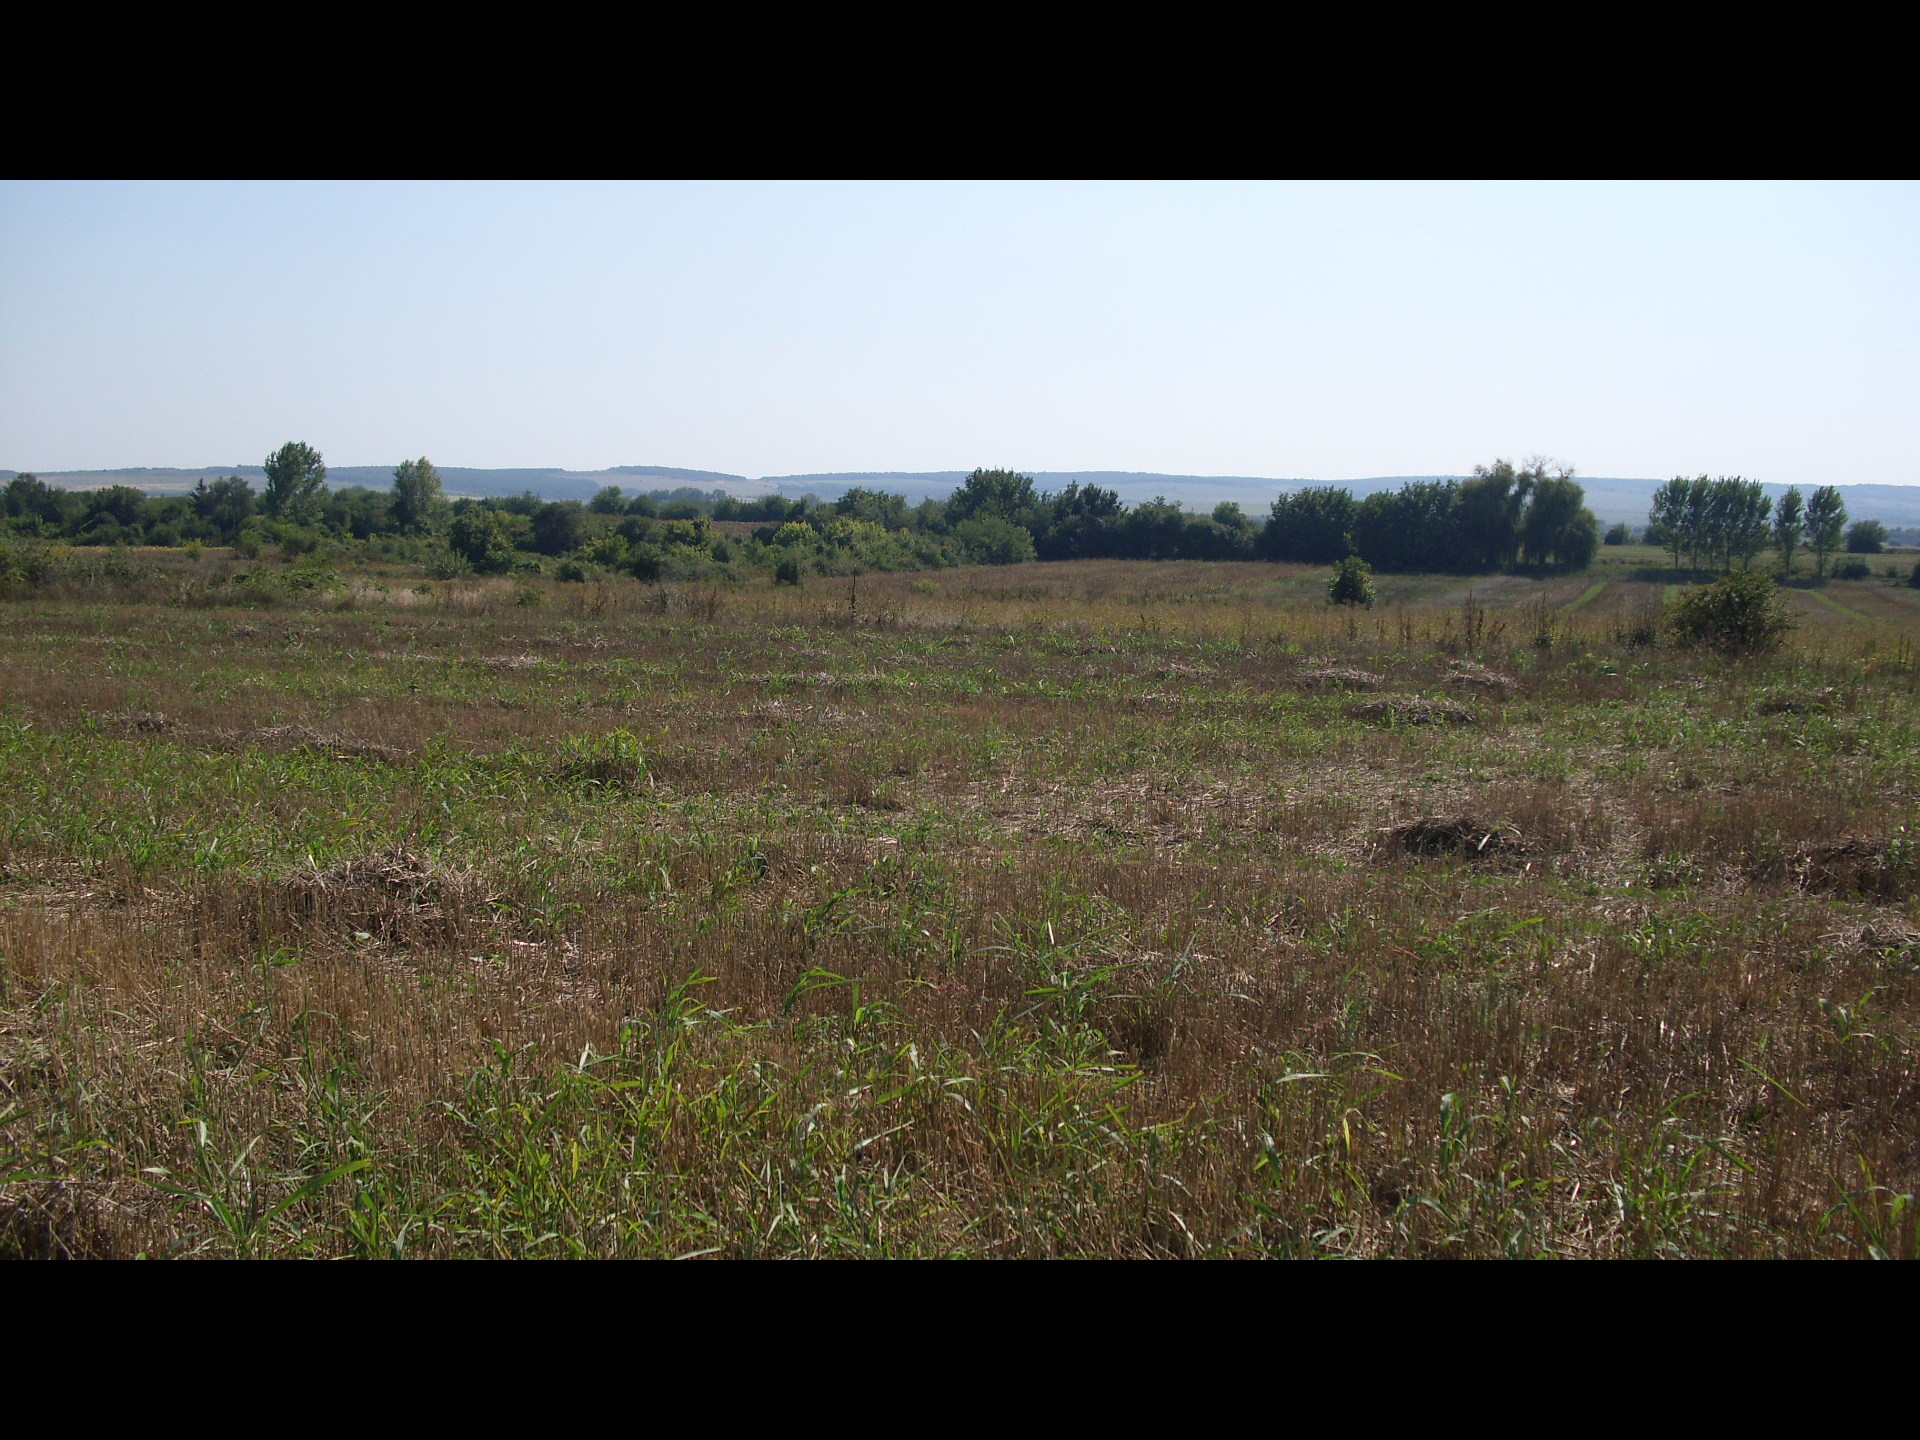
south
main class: Cropland
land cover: Common wheat
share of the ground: > 75 %
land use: Agriculture (excluding fallow land and kitchen gardens)
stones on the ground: < 10 %
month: August
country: BG
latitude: 44.1353
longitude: 22.6747
